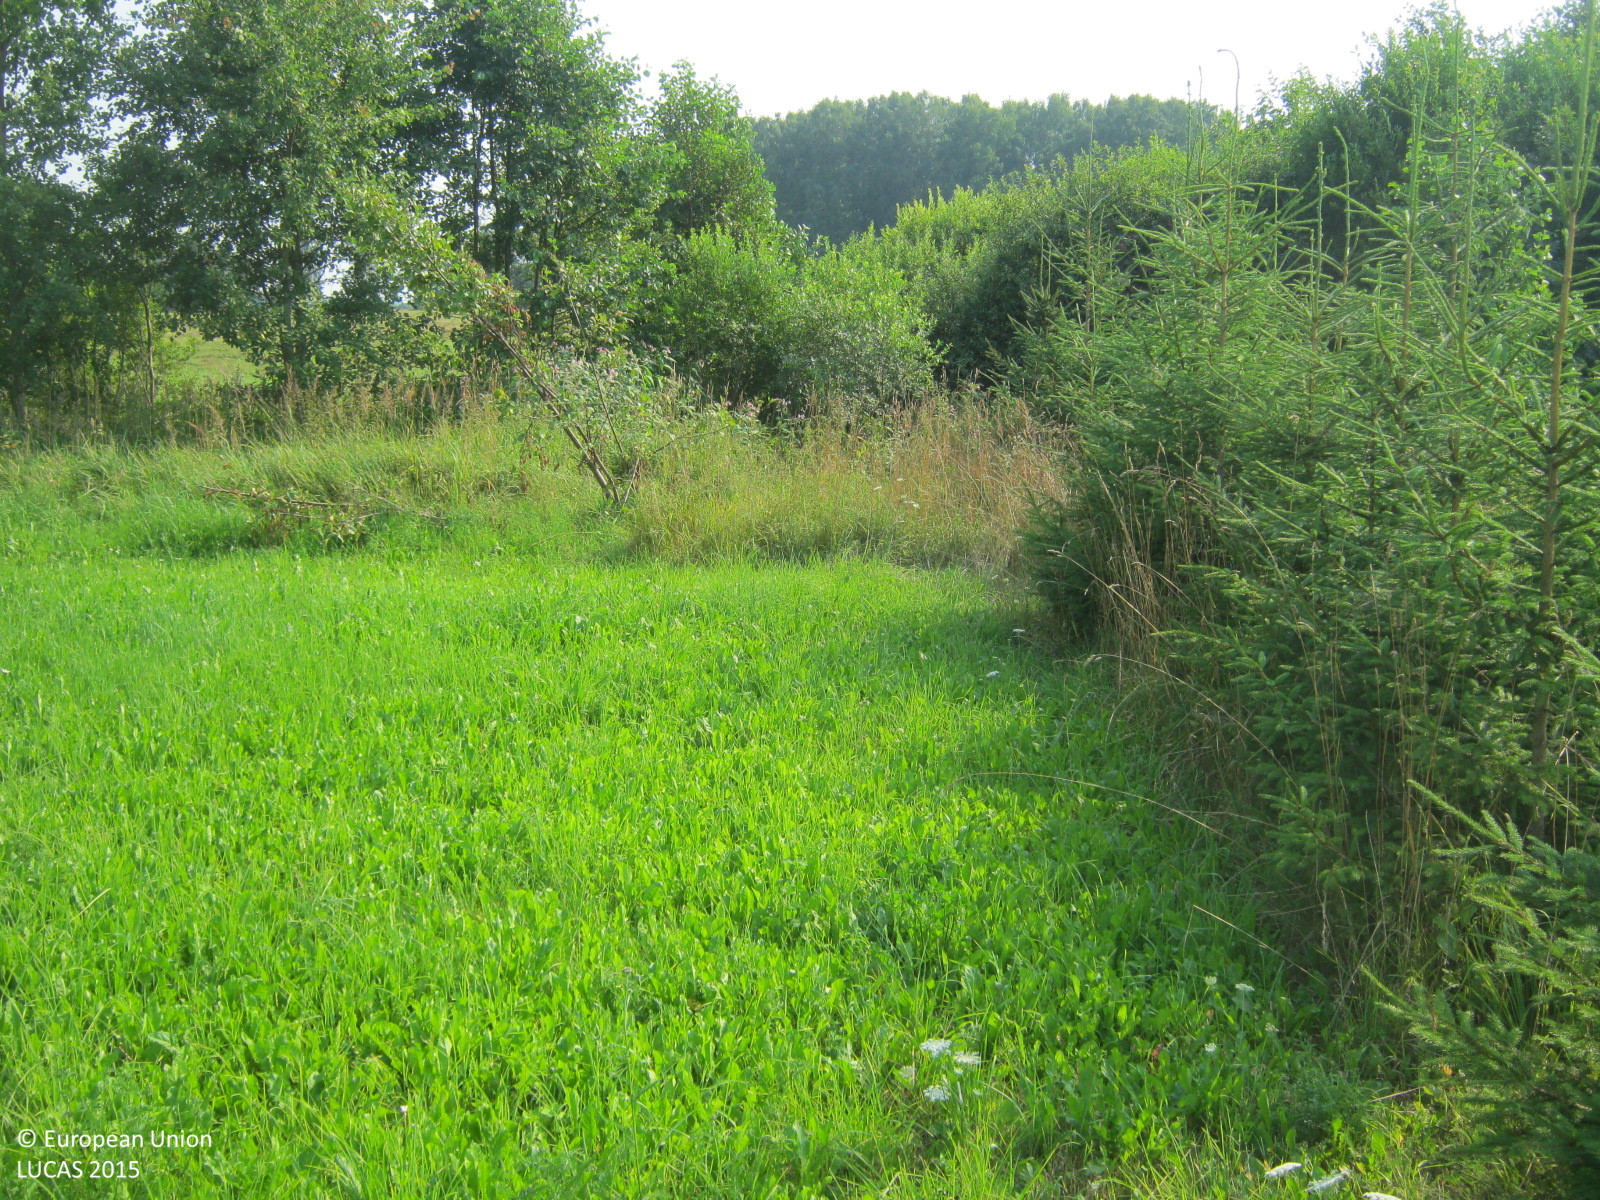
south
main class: Grassland
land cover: Grassland without tree/shrub cover
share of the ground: > 75 %
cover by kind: herbaceous plants 100 %
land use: Agriculture (excluding fallow land and kitchen gardens)
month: August
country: LV
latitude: 57.4346
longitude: 24.4319
